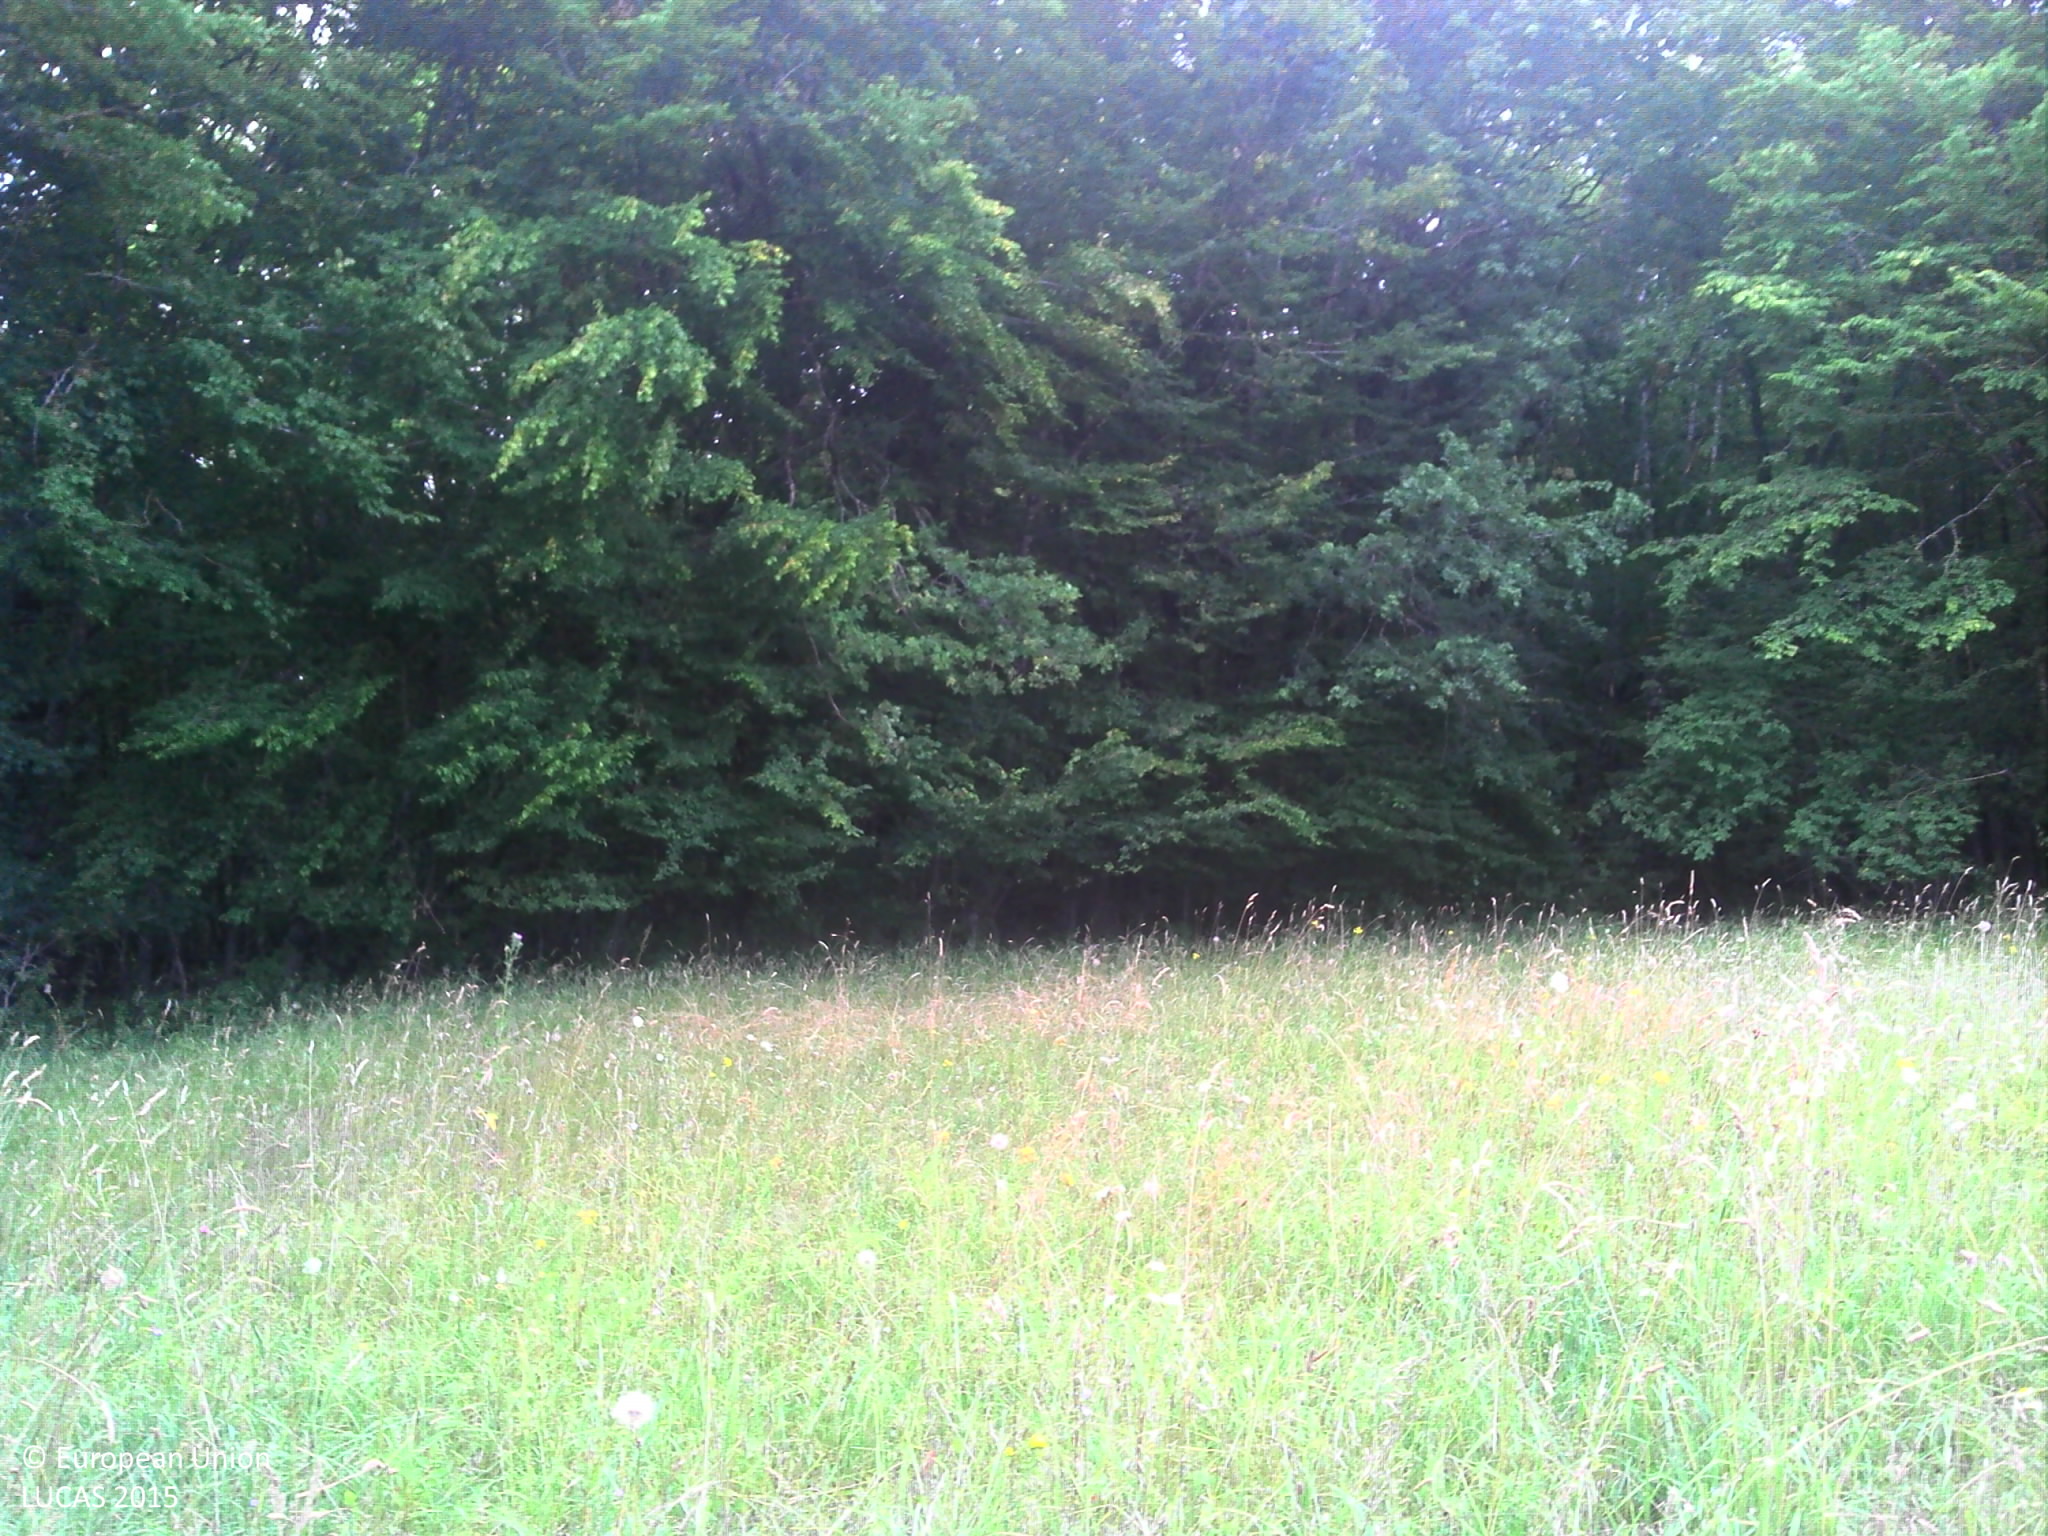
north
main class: Cropland
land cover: Rape and turnip rape
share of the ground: > 75 %
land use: Agriculture (excluding fallow land and kitchen gardens)
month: July
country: FR
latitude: 48.0833
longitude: 5.2070
